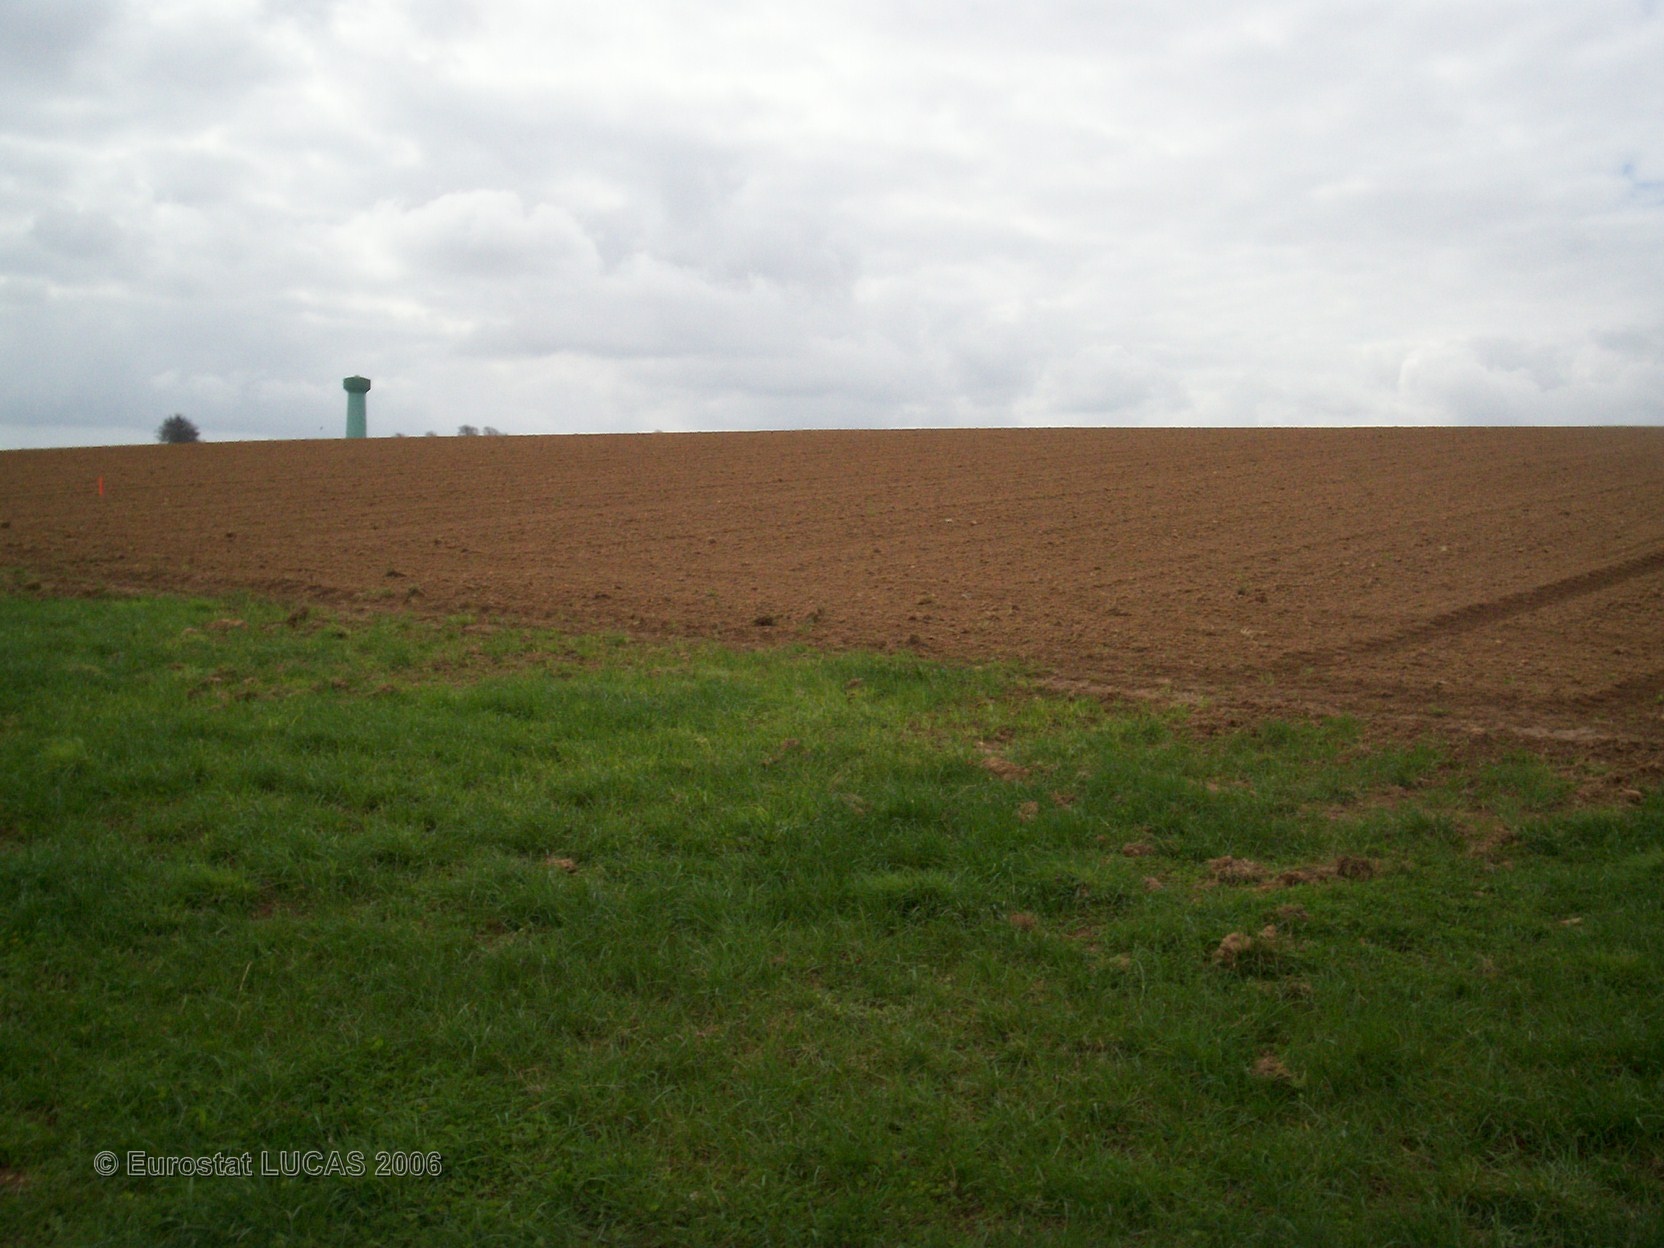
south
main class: Grassland
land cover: Grassland without tree/shrub cover
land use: Agriculture (excluding fallow land and kitchen gardens)
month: April
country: FR
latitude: 49.7306
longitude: 0.9173
